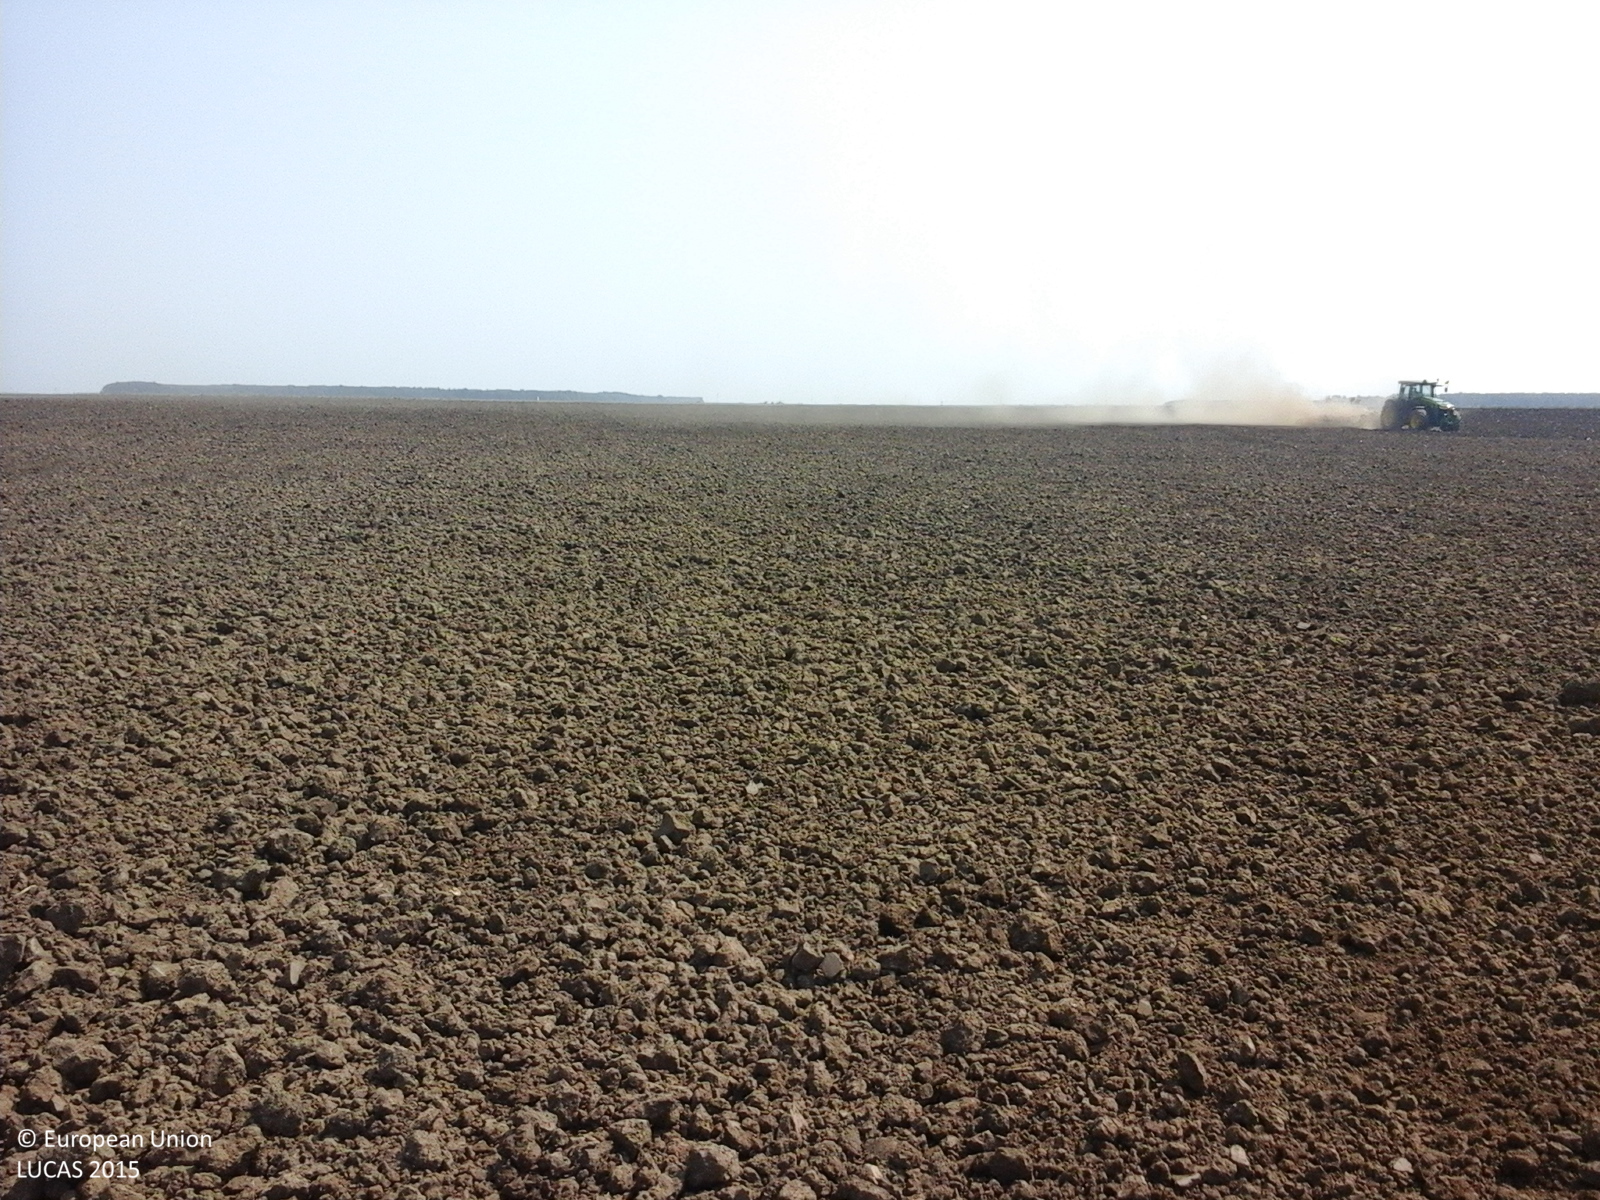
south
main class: Cropland
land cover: Rape and turnip rape
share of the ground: < 10 %
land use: Agriculture (excluding fallow land and kitchen gardens)
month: July
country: RO
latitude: 44.5972
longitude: 26.7396
